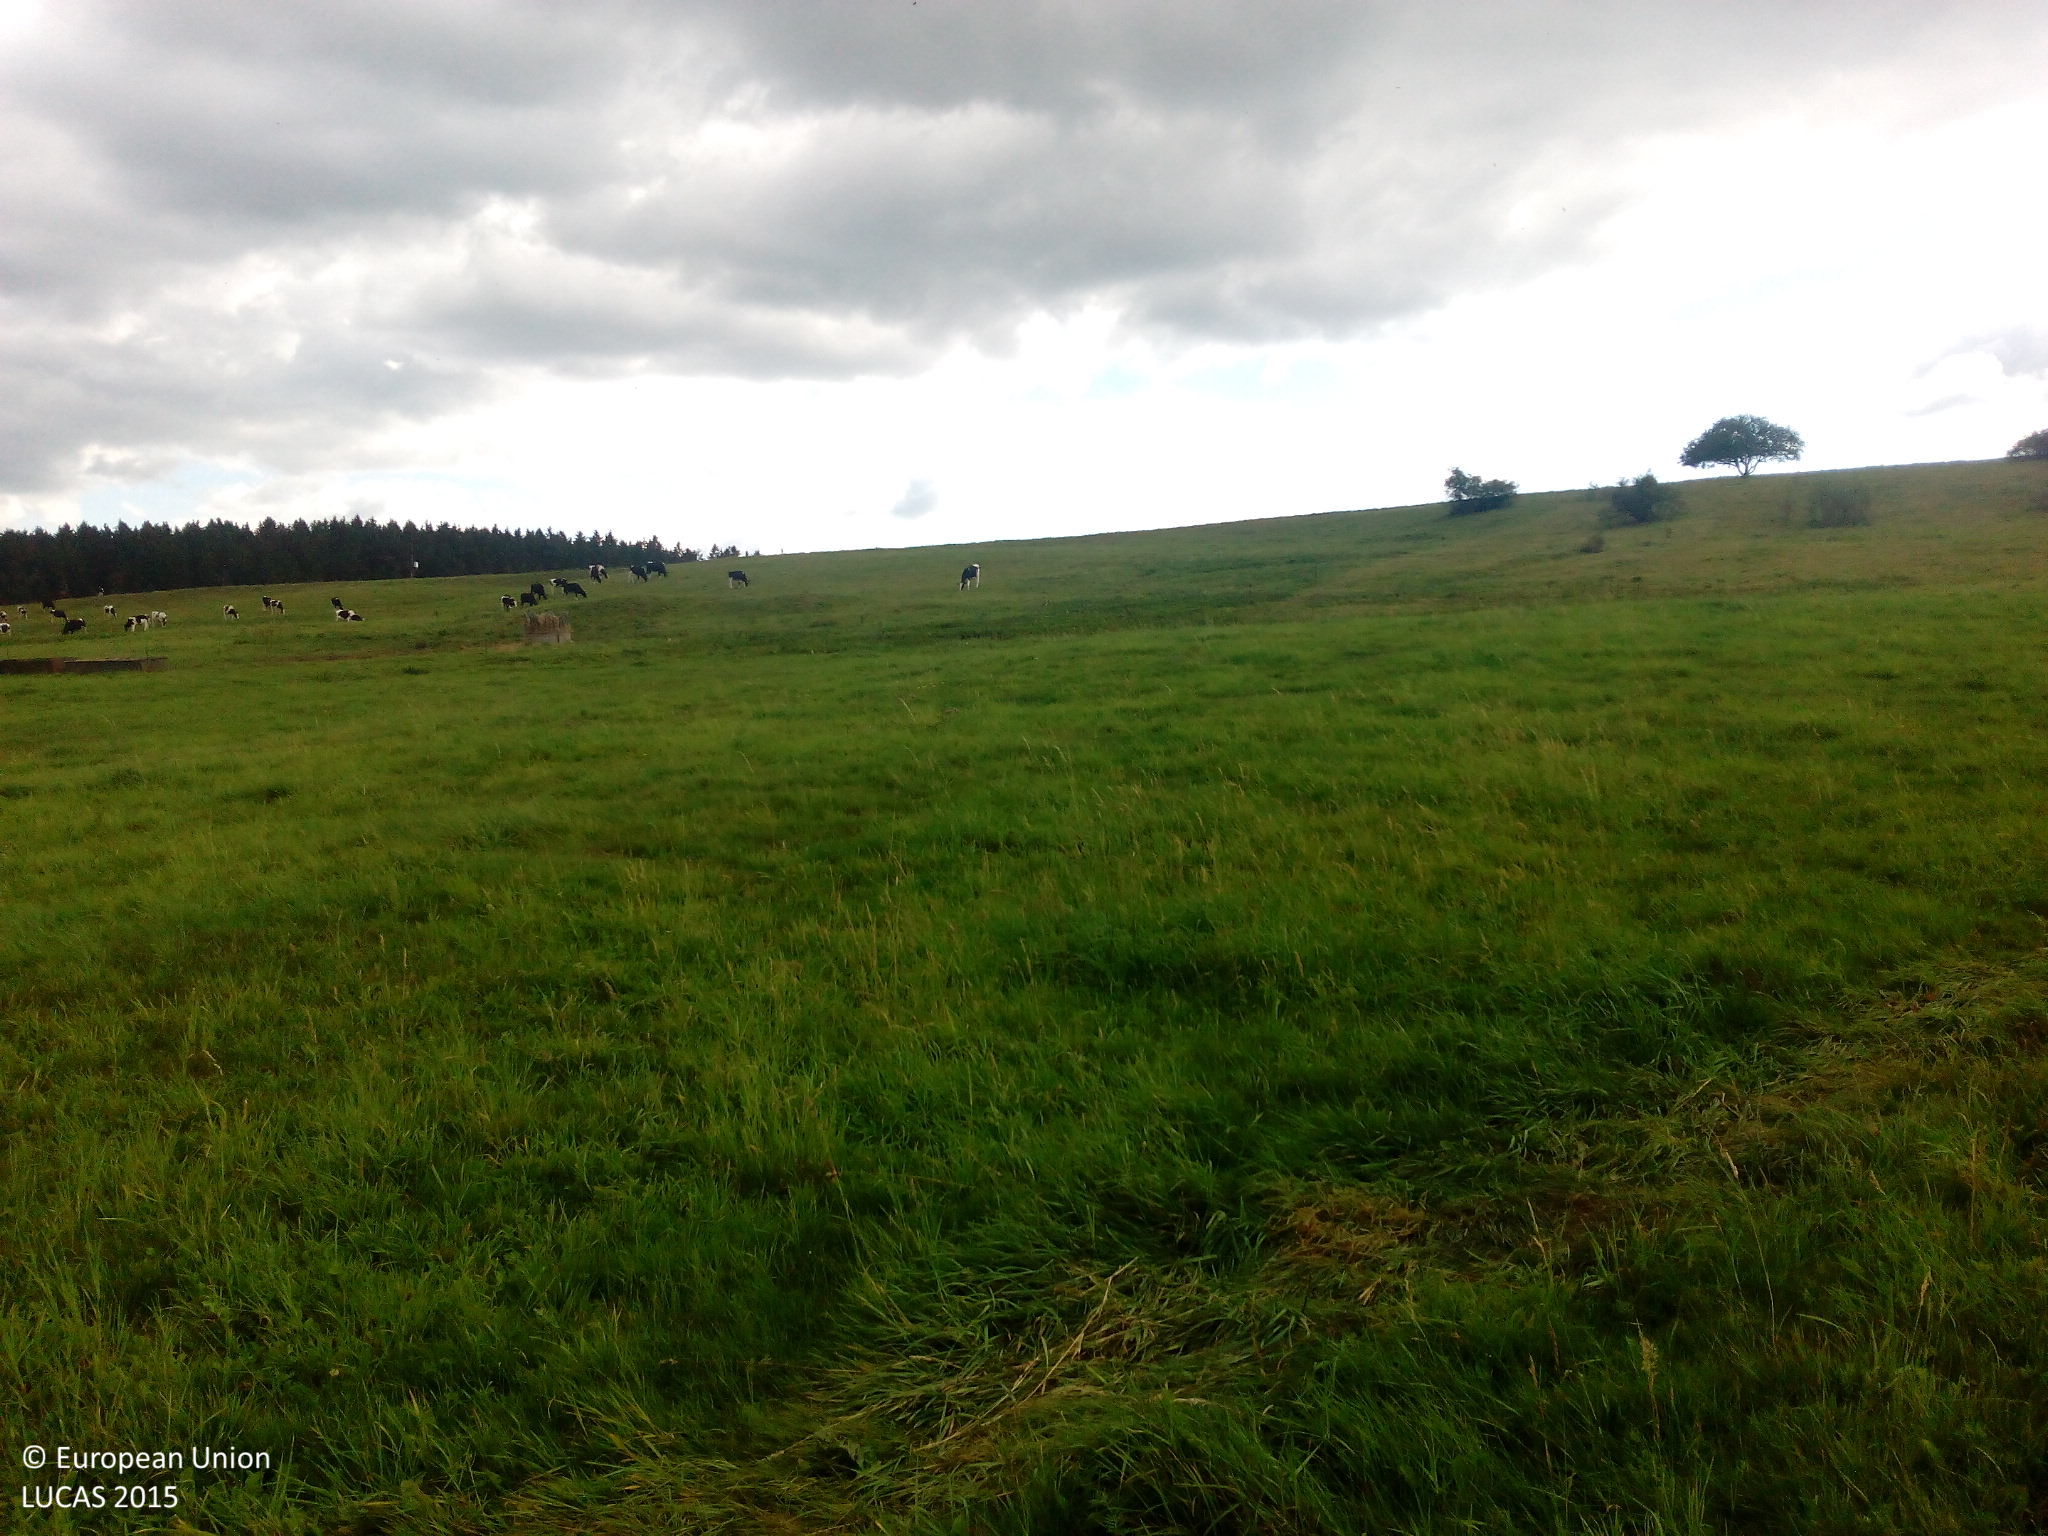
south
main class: Grassland
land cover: Grassland without tree/shrub cover
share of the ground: > 75 %
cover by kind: herbaceous plants 100 %
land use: Agriculture (excluding fallow land and kitchen gardens)
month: September
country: DE
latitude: 51.6188
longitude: 10.9385
